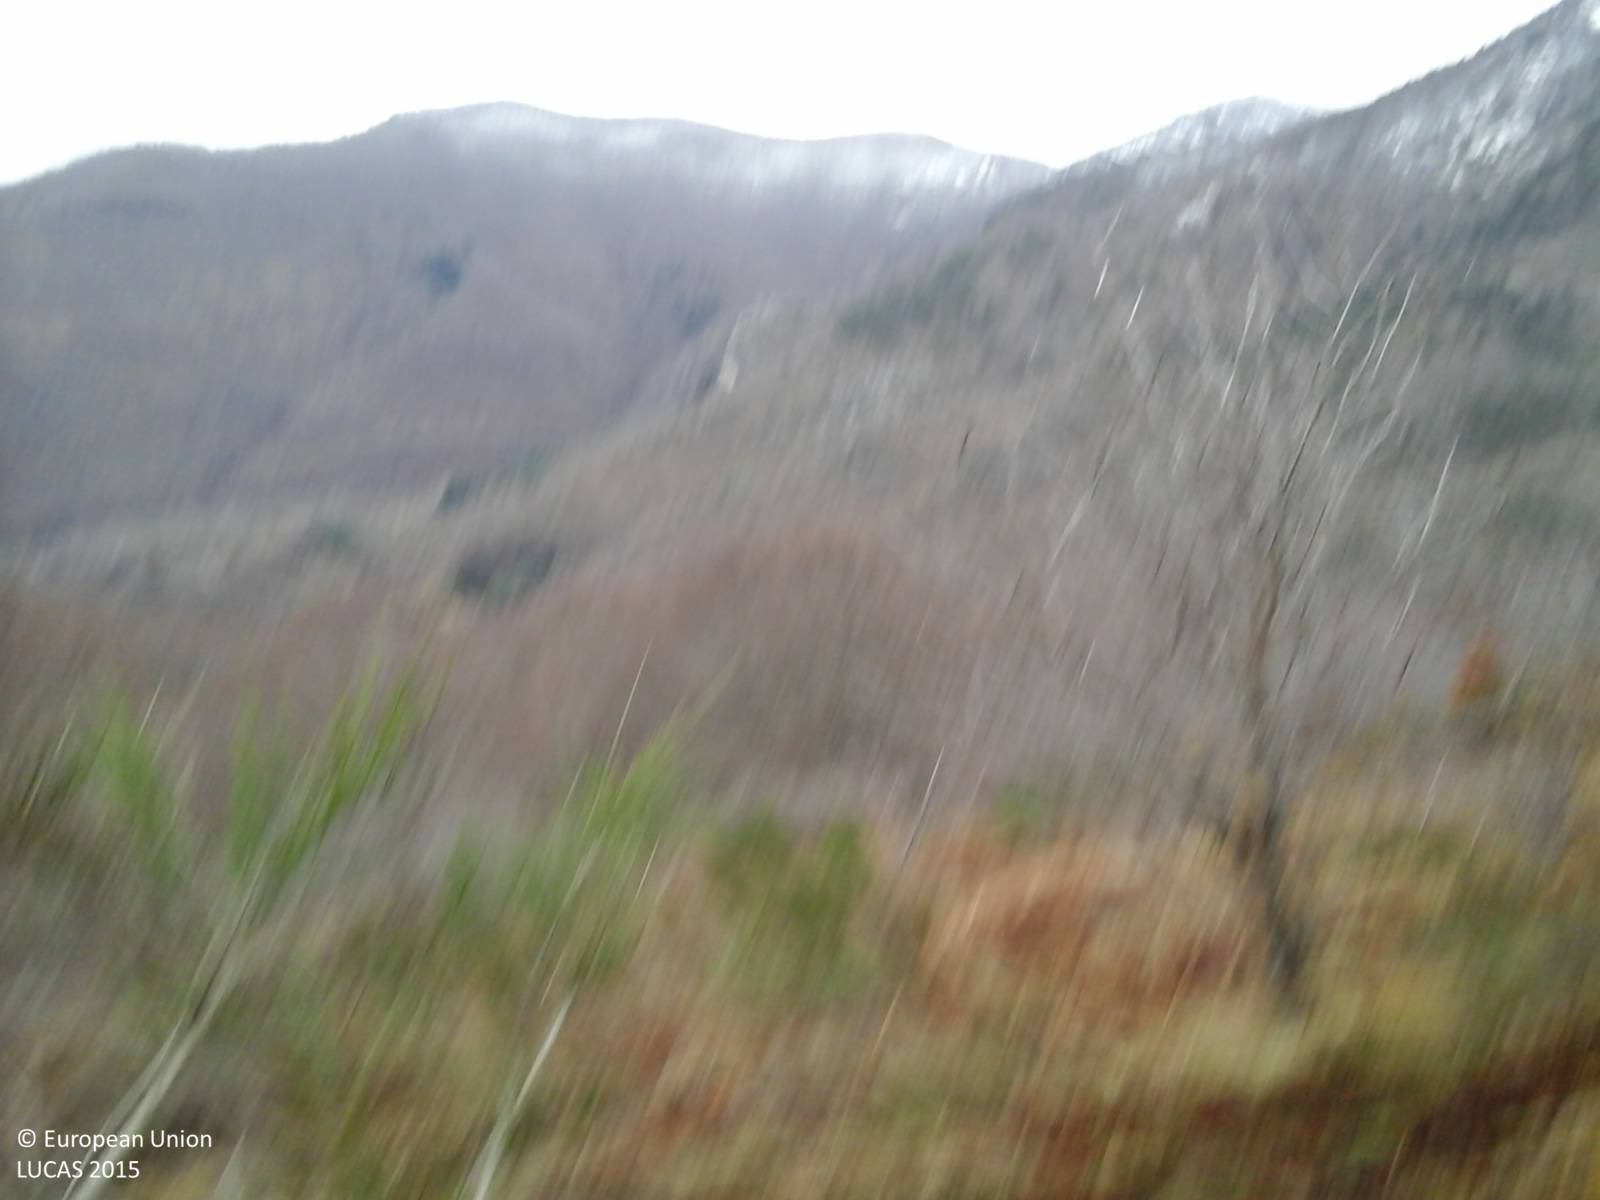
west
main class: Shrubland
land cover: Shrubland with sparse tree cover
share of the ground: > 75 %
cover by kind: shrubs 90 %, broadleaved forest trees 5 %, herbaceous plants 5 %
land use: Semi-natural and natural areas not in use
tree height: < 5 m
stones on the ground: 25 - 50 %
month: January
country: IT
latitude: 44.0962
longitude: 10.6106
